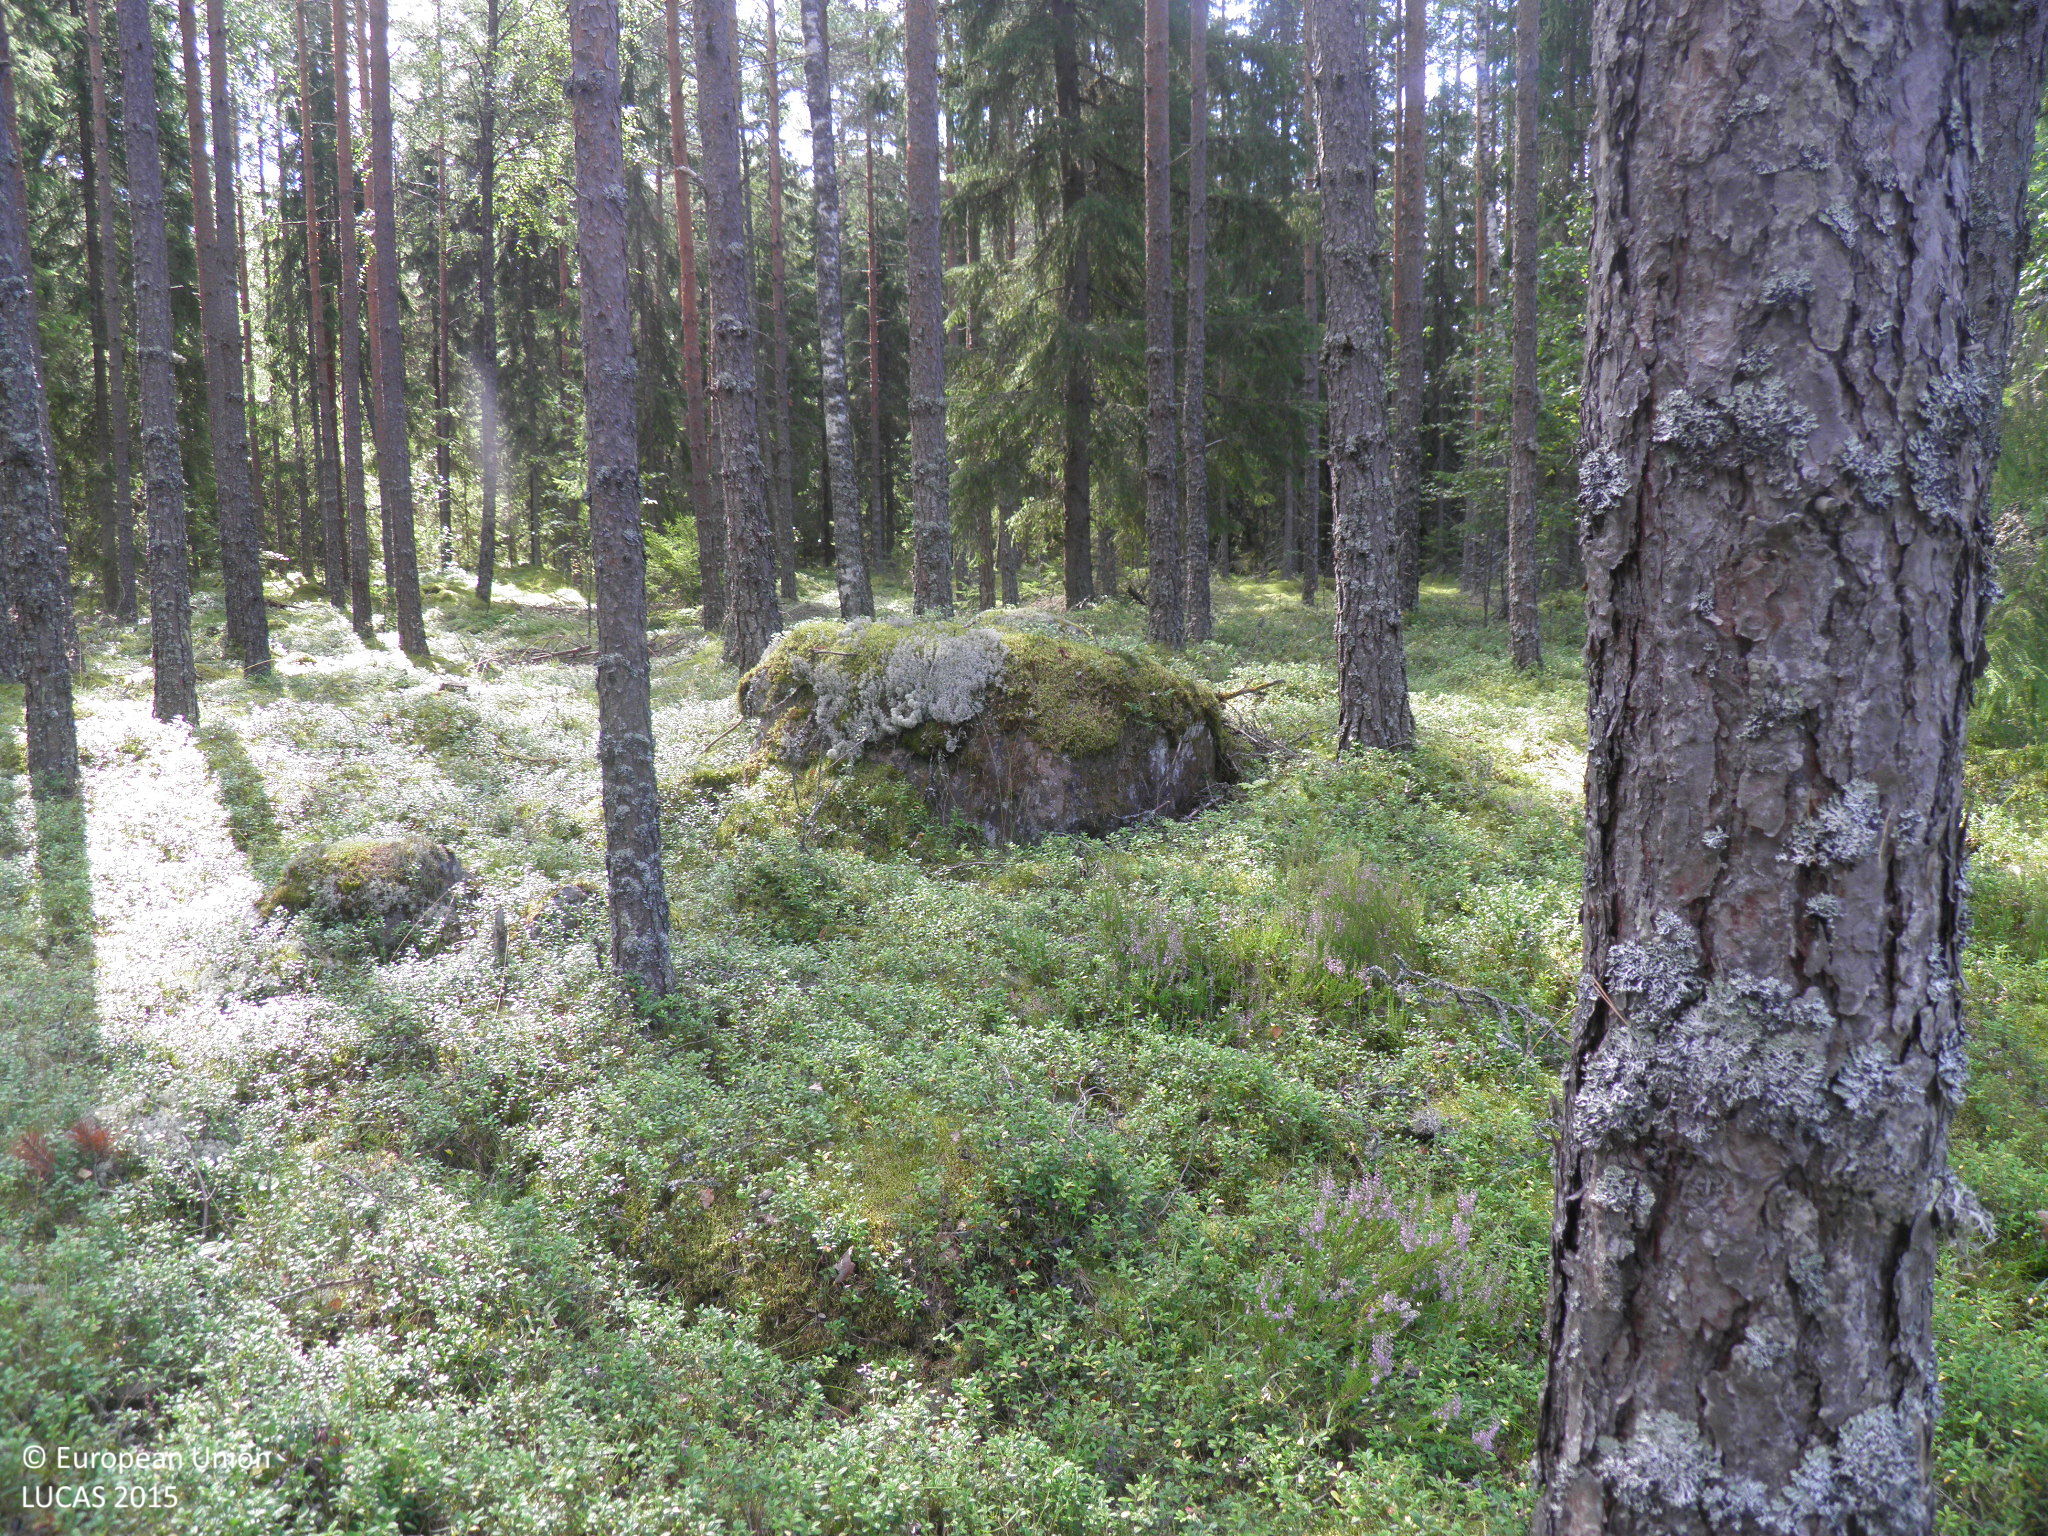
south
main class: Woodland
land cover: Pine dominated coniferous woodland
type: hemiboreal forest and nemoral coniferous forest and mixed broadleaved-coniferous forest
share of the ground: 25 - 50 %
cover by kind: coniferous forest trees 35 %, shrubs 30 %, lichens and mosses 30 %, broadleaved forest trees 5 %
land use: Forestry
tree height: > 5 m
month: August
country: FI
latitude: 61.0286
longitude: 22.0721
